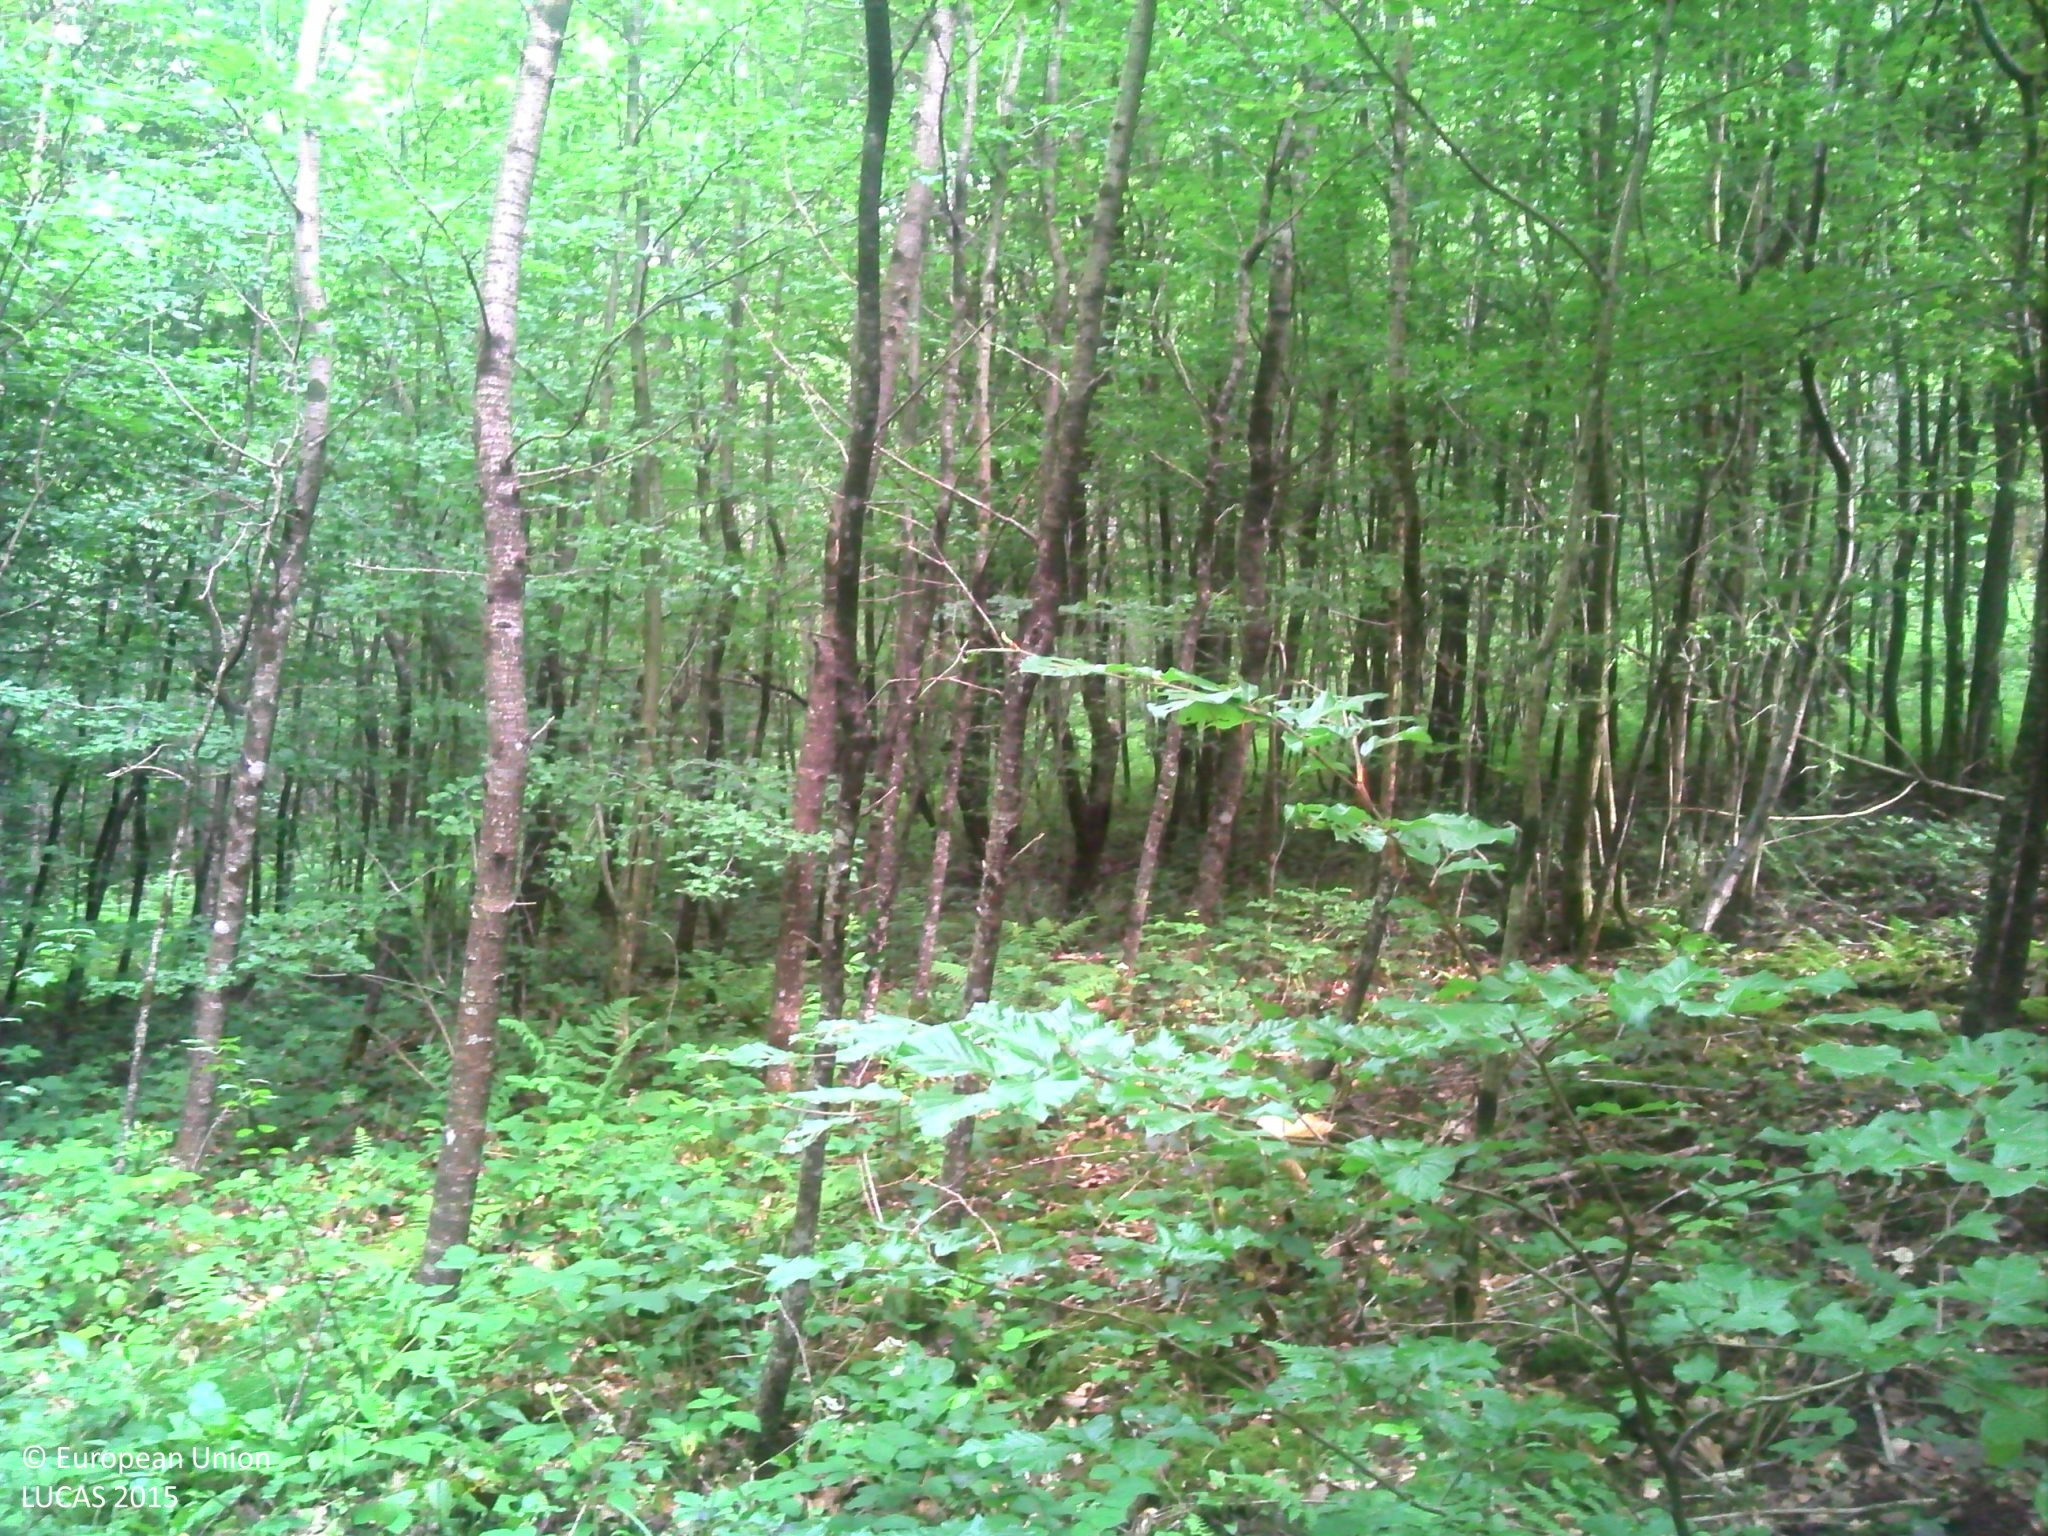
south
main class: Woodland
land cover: Broadleaved woodland
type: beech forest
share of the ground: > 75 %
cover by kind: broadleaved forest trees 90 %, herbaceous plants 10 %
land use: Forestry
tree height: > 5 m
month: June
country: FR
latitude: 47.8390
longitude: 6.3535
